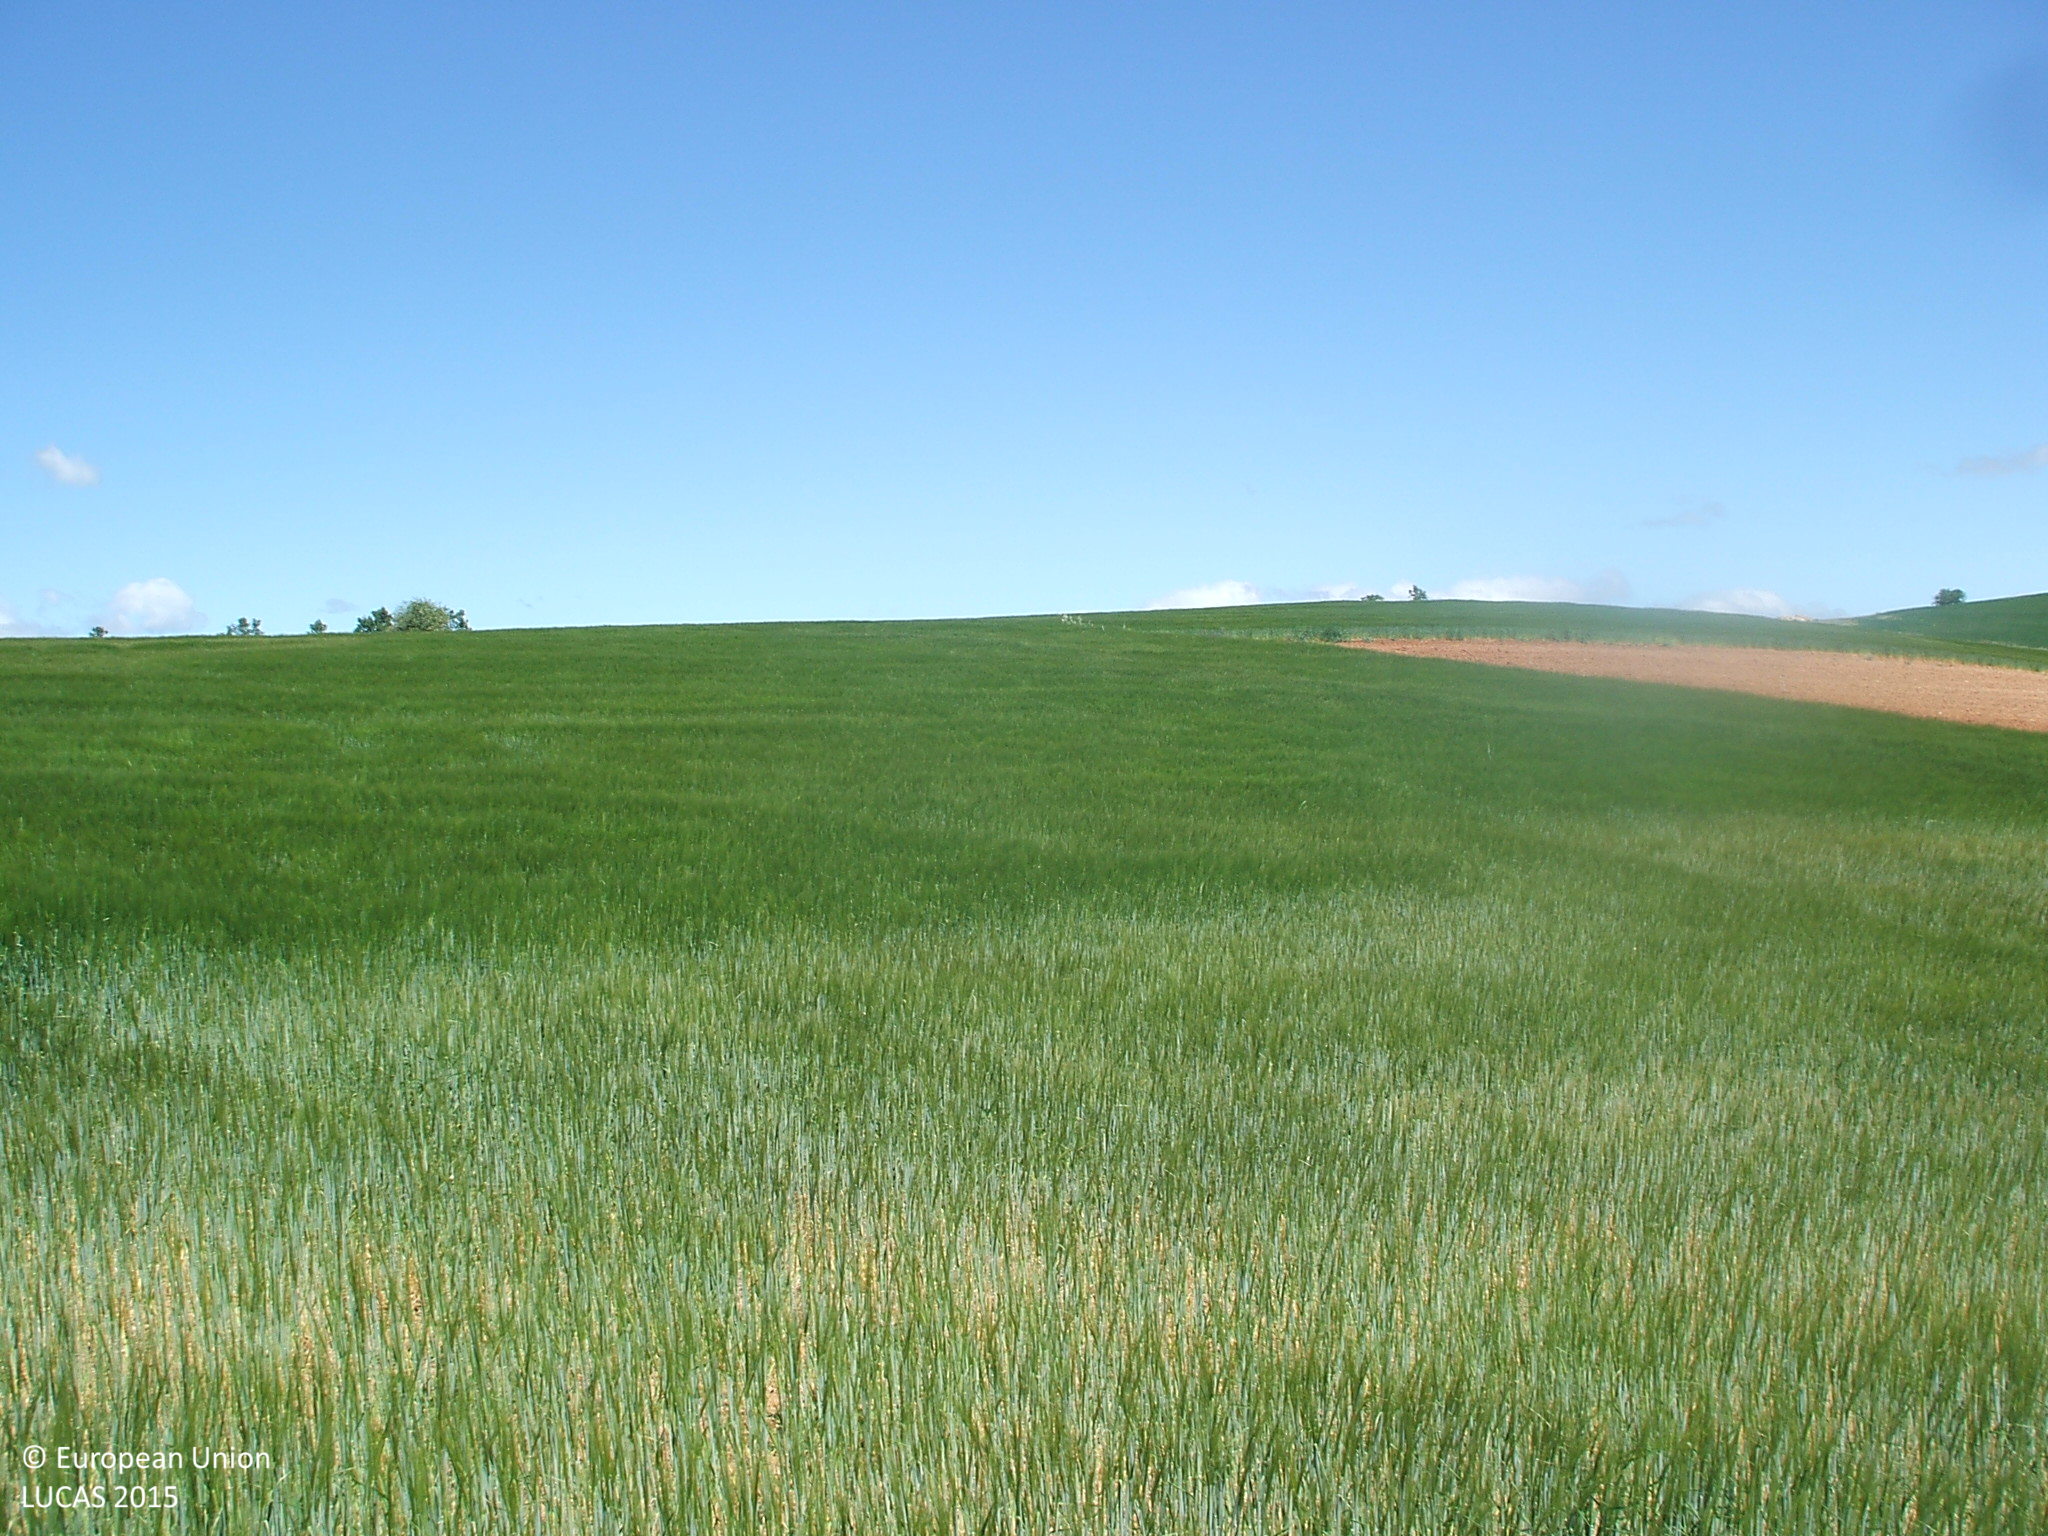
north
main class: Cropland
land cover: Barley
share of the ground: > 75 %
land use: Agriculture (excluding fallow land and kitchen gardens)
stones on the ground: 25 - 50 %
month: May
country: ES
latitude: 40.9691
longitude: -2.8794
